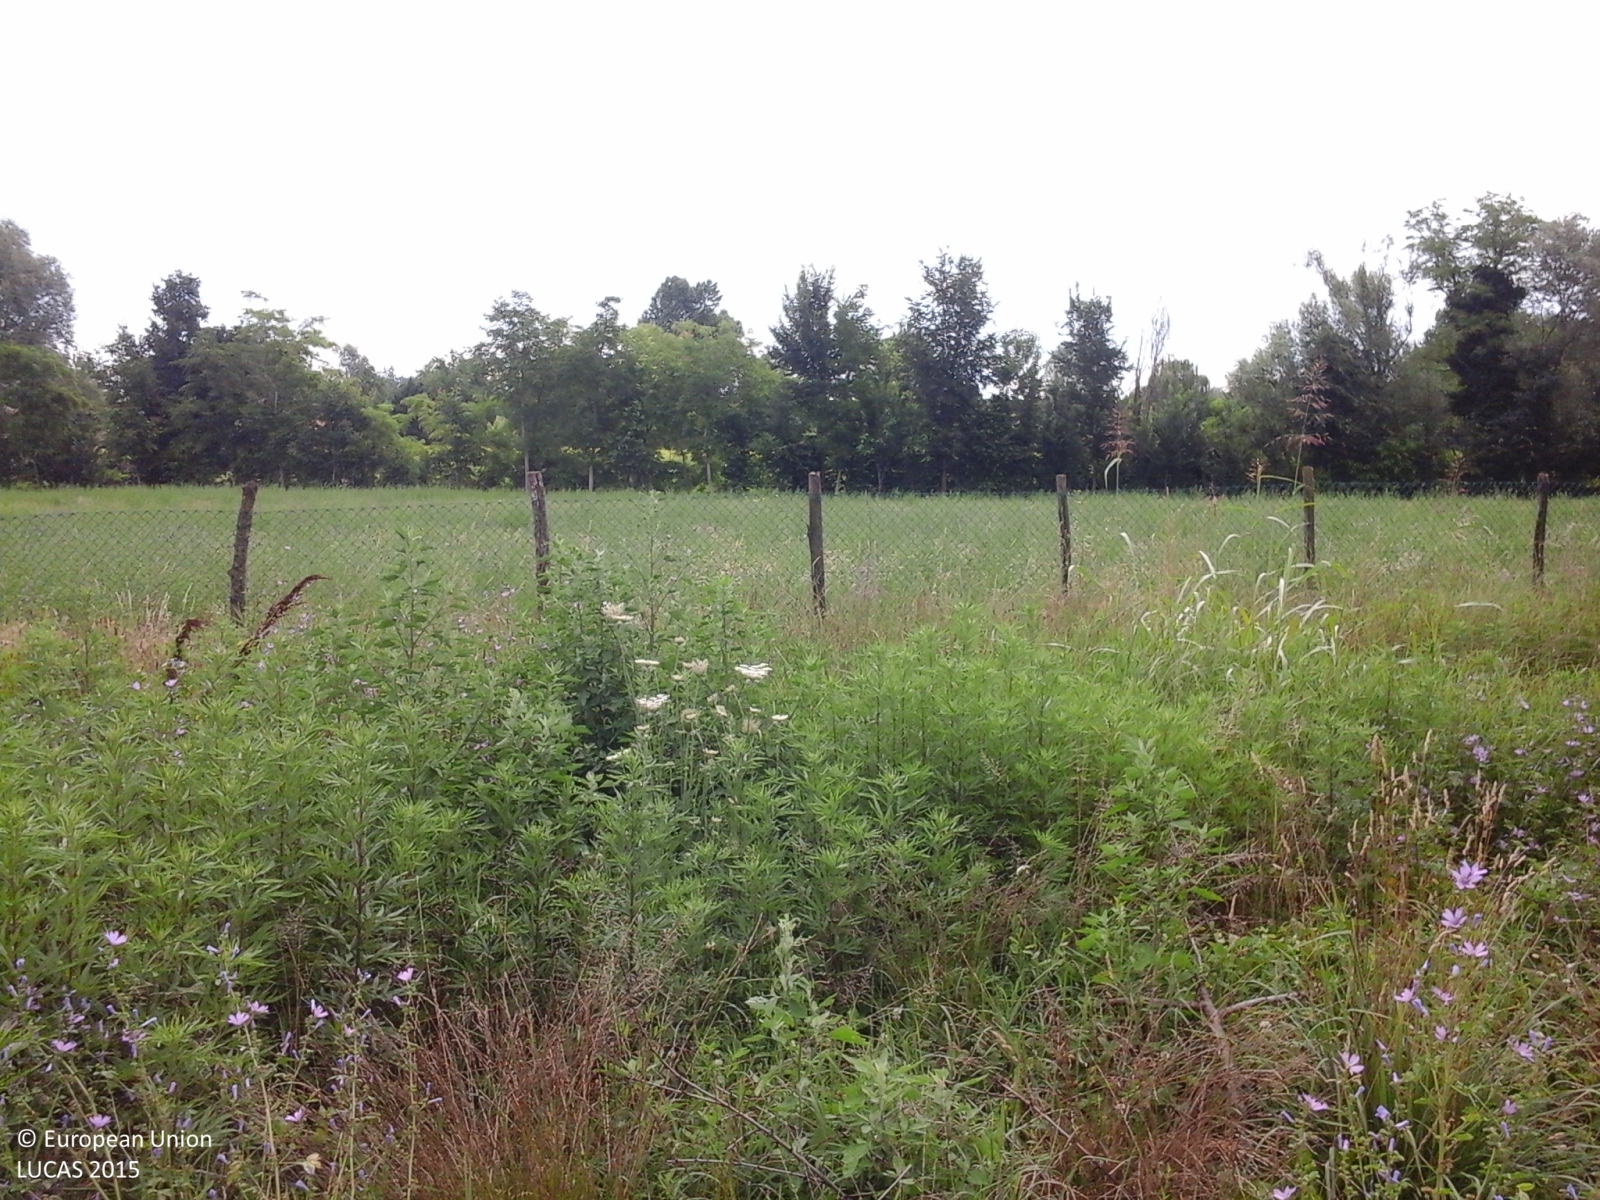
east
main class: Grassland
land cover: Spontaneously vegetated surfaces
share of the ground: > 75 %
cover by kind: herbaceous plants 100 %
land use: Fallow land
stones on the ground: < 10 %
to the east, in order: Spontaneously vegetated surfaces; Fences; Lucerne; Managed hedges; Ditches and canals; Managed hedges; Spontaneously vegetated surfaces; Ditches and canals; Rape and turnip rape; Ditches and canals; Abandoned hedges; Artificial constructions in urban areas
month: June
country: IT
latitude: 45.6731
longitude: 12.4997
